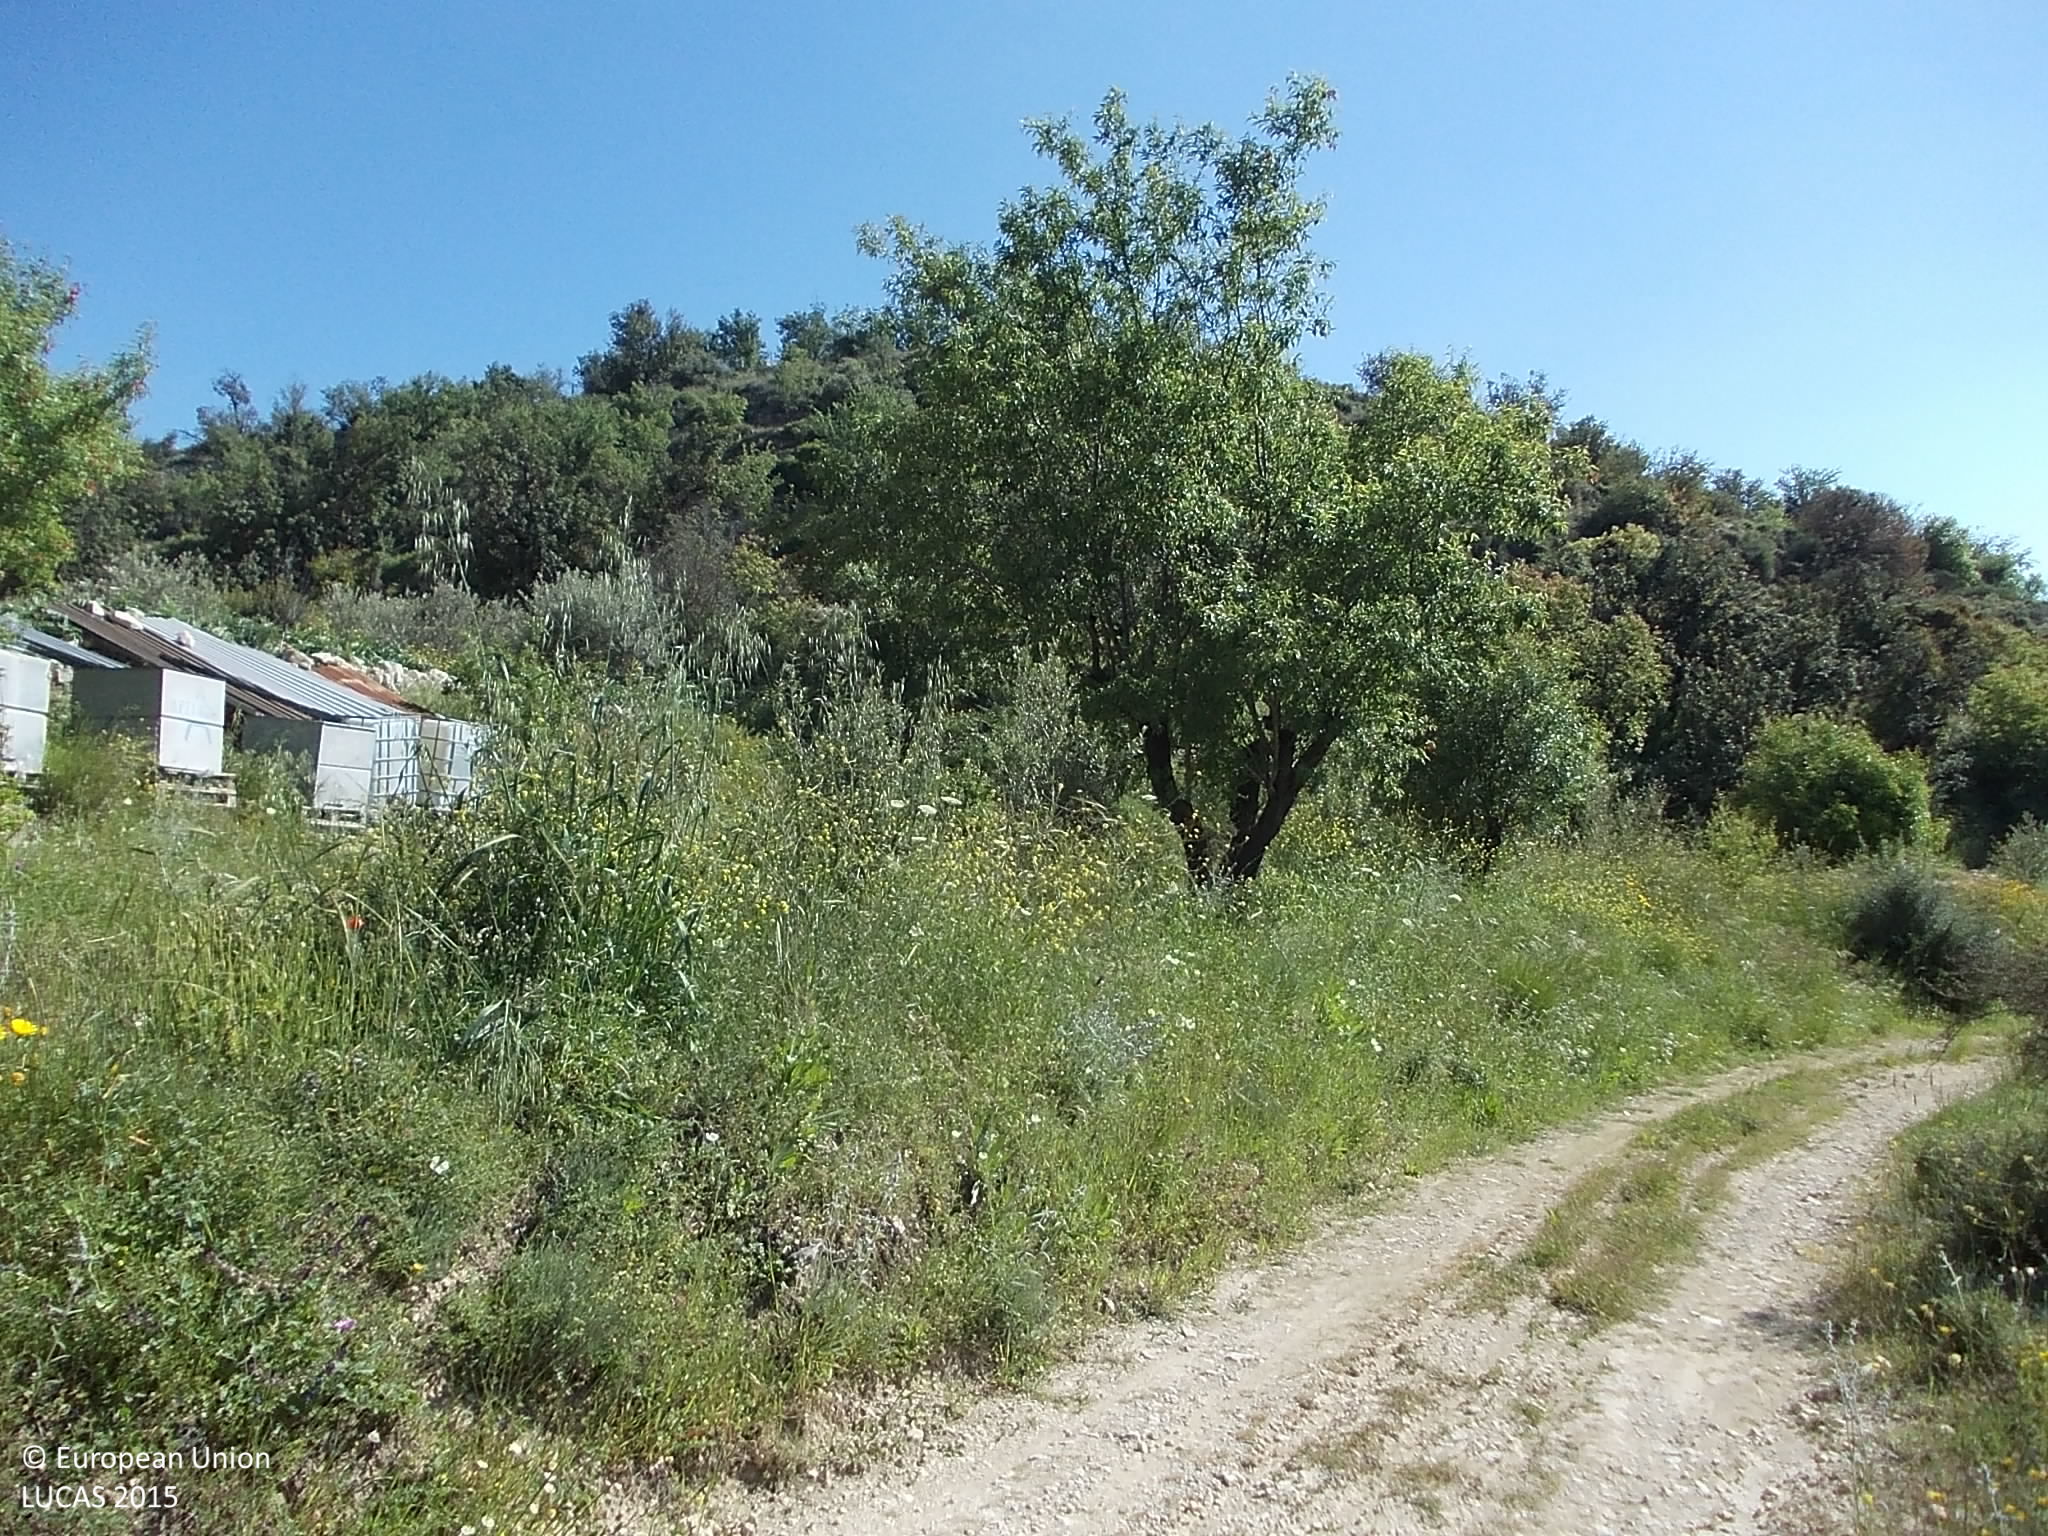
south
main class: Shrubland
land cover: Shrubland with sparse tree cover
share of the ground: > 75 %
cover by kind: shrubs 85 %, herbaceous plants 10 %, coniferous forest trees 5 %
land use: Semi-natural and natural areas not in use
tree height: < 5 m
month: April
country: CY
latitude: 34.7663
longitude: 33.0350
